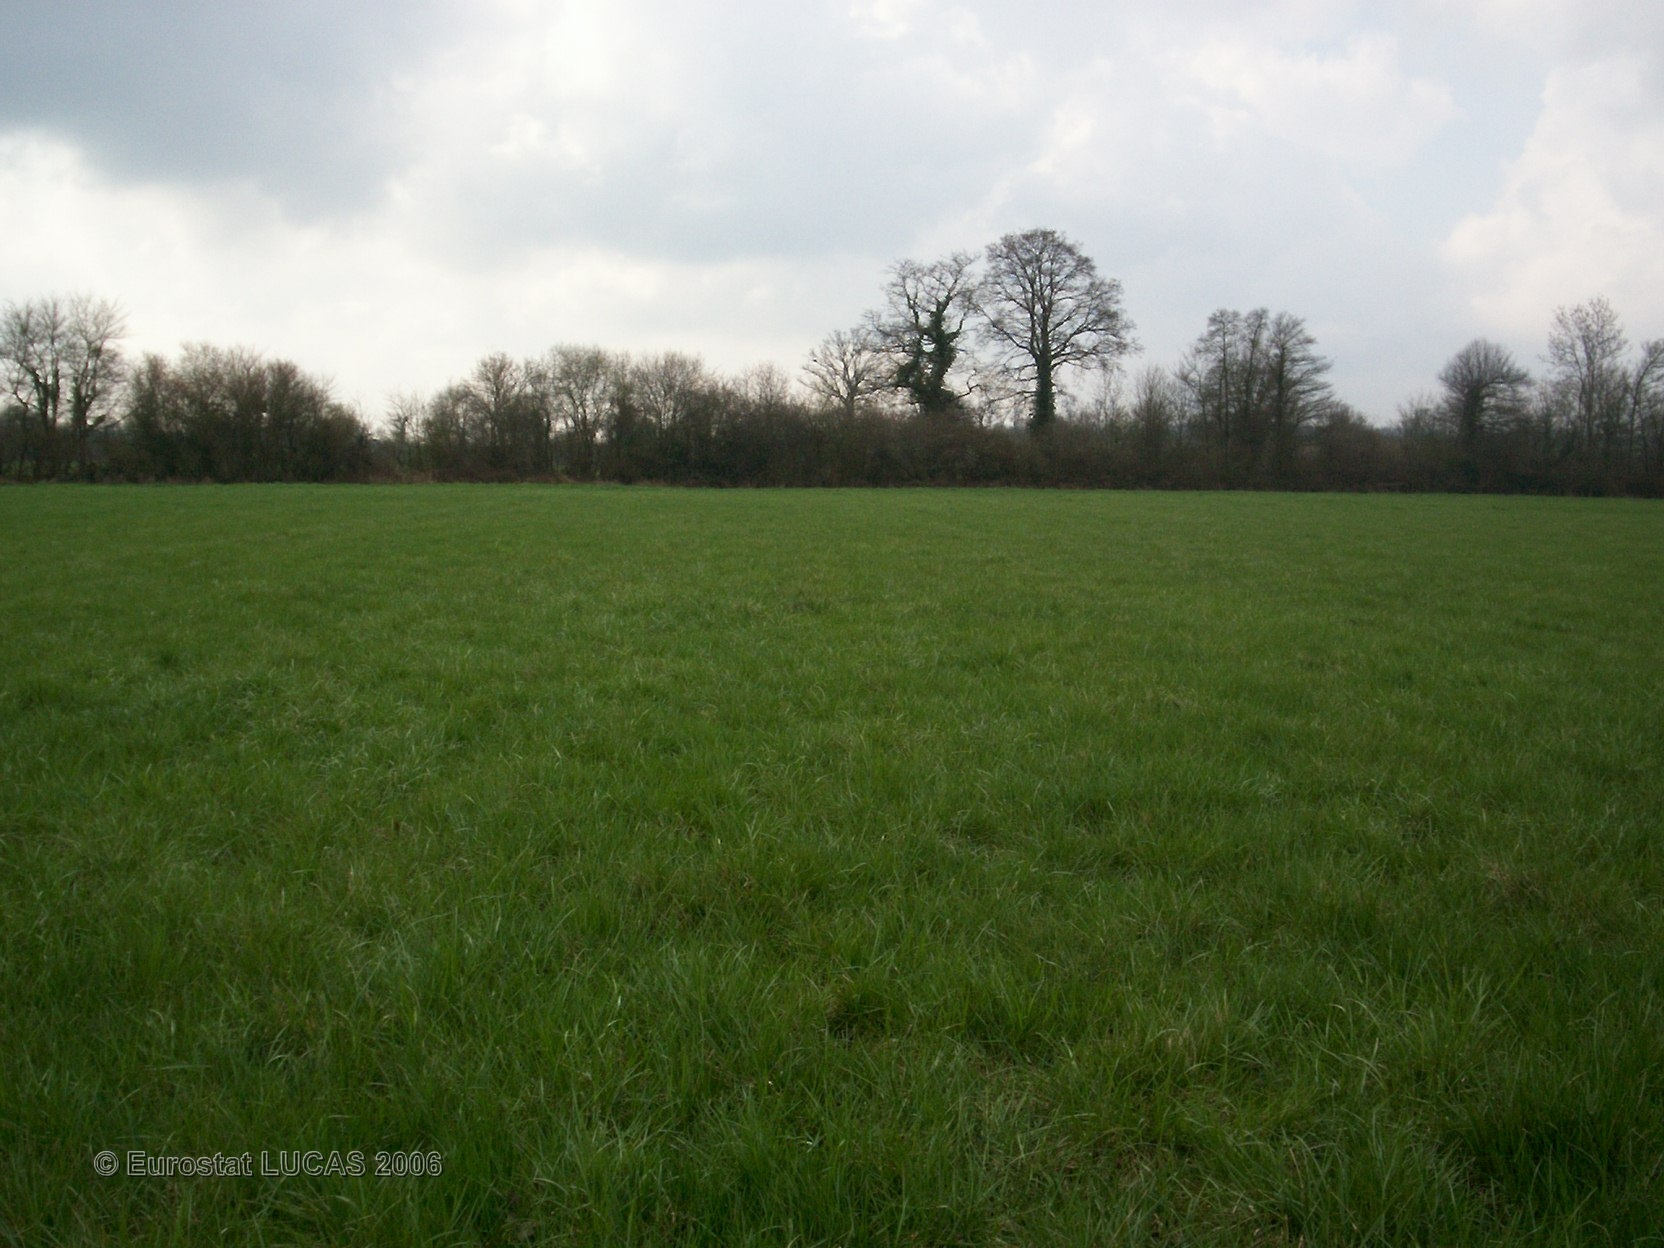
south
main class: Grassland
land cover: Grassland without tree/shrub cover
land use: Agriculture (excluding fallow land and kitchen gardens)
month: April
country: FR
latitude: 48.9297
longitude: 0.0191
